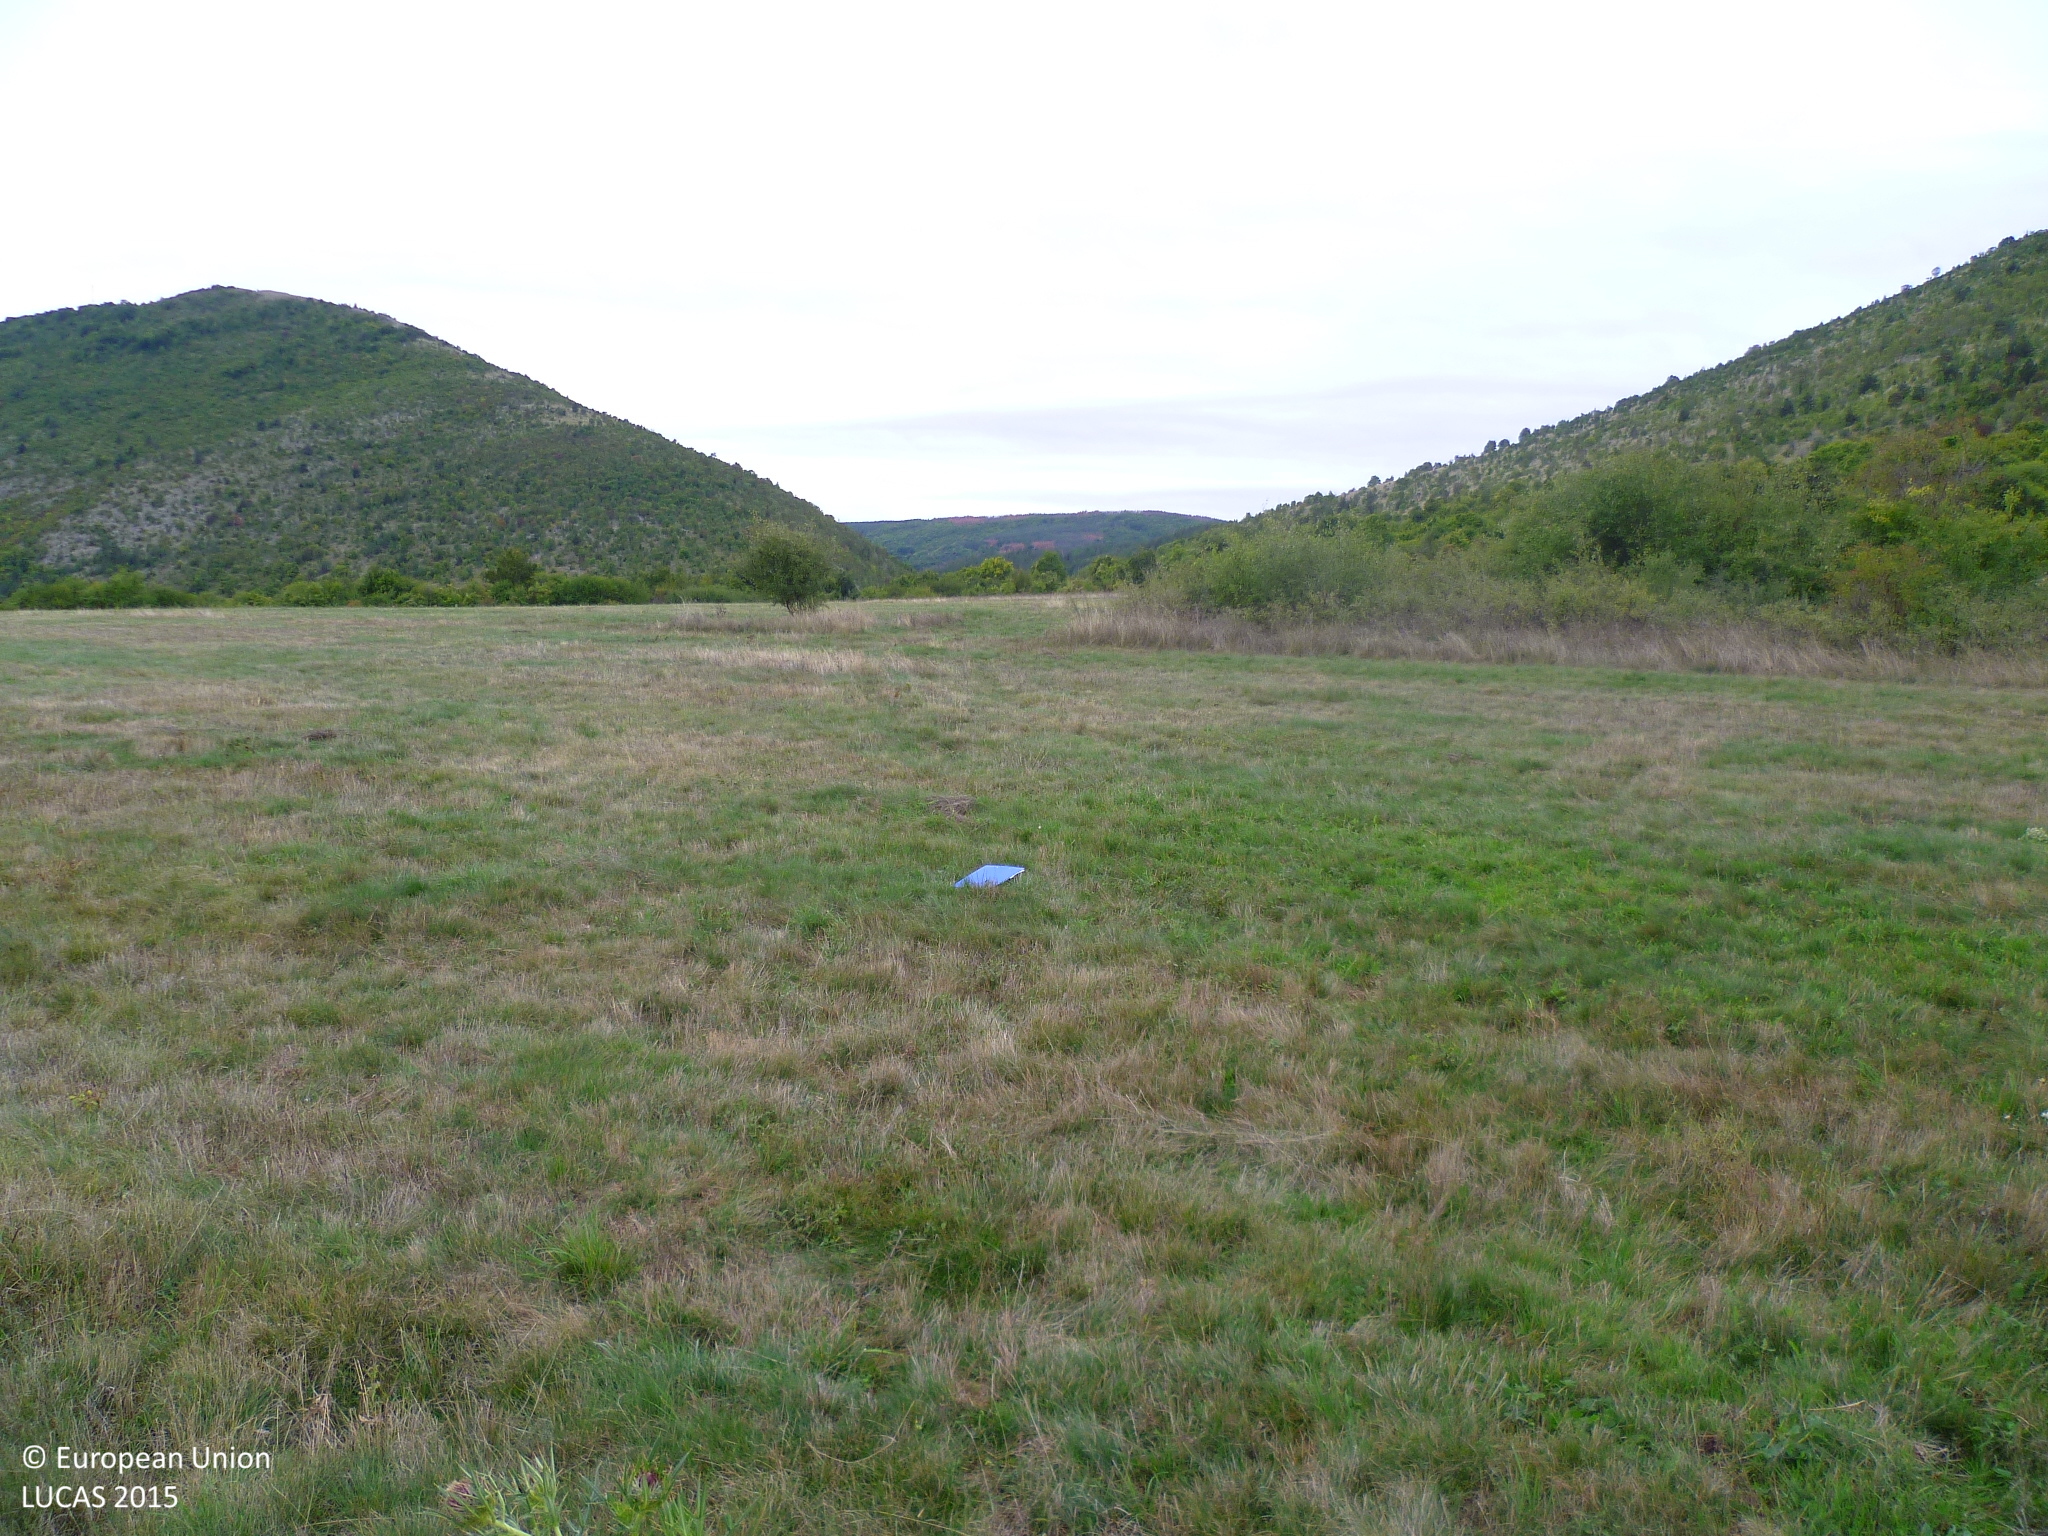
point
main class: Grassland
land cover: Grassland without tree/shrub cover
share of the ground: > 75 %
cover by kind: herbaceous plants 100 %
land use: Agriculture (excluding fallow land and kitchen gardens)
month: September
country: BG
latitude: 42.7549
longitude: 22.7709
